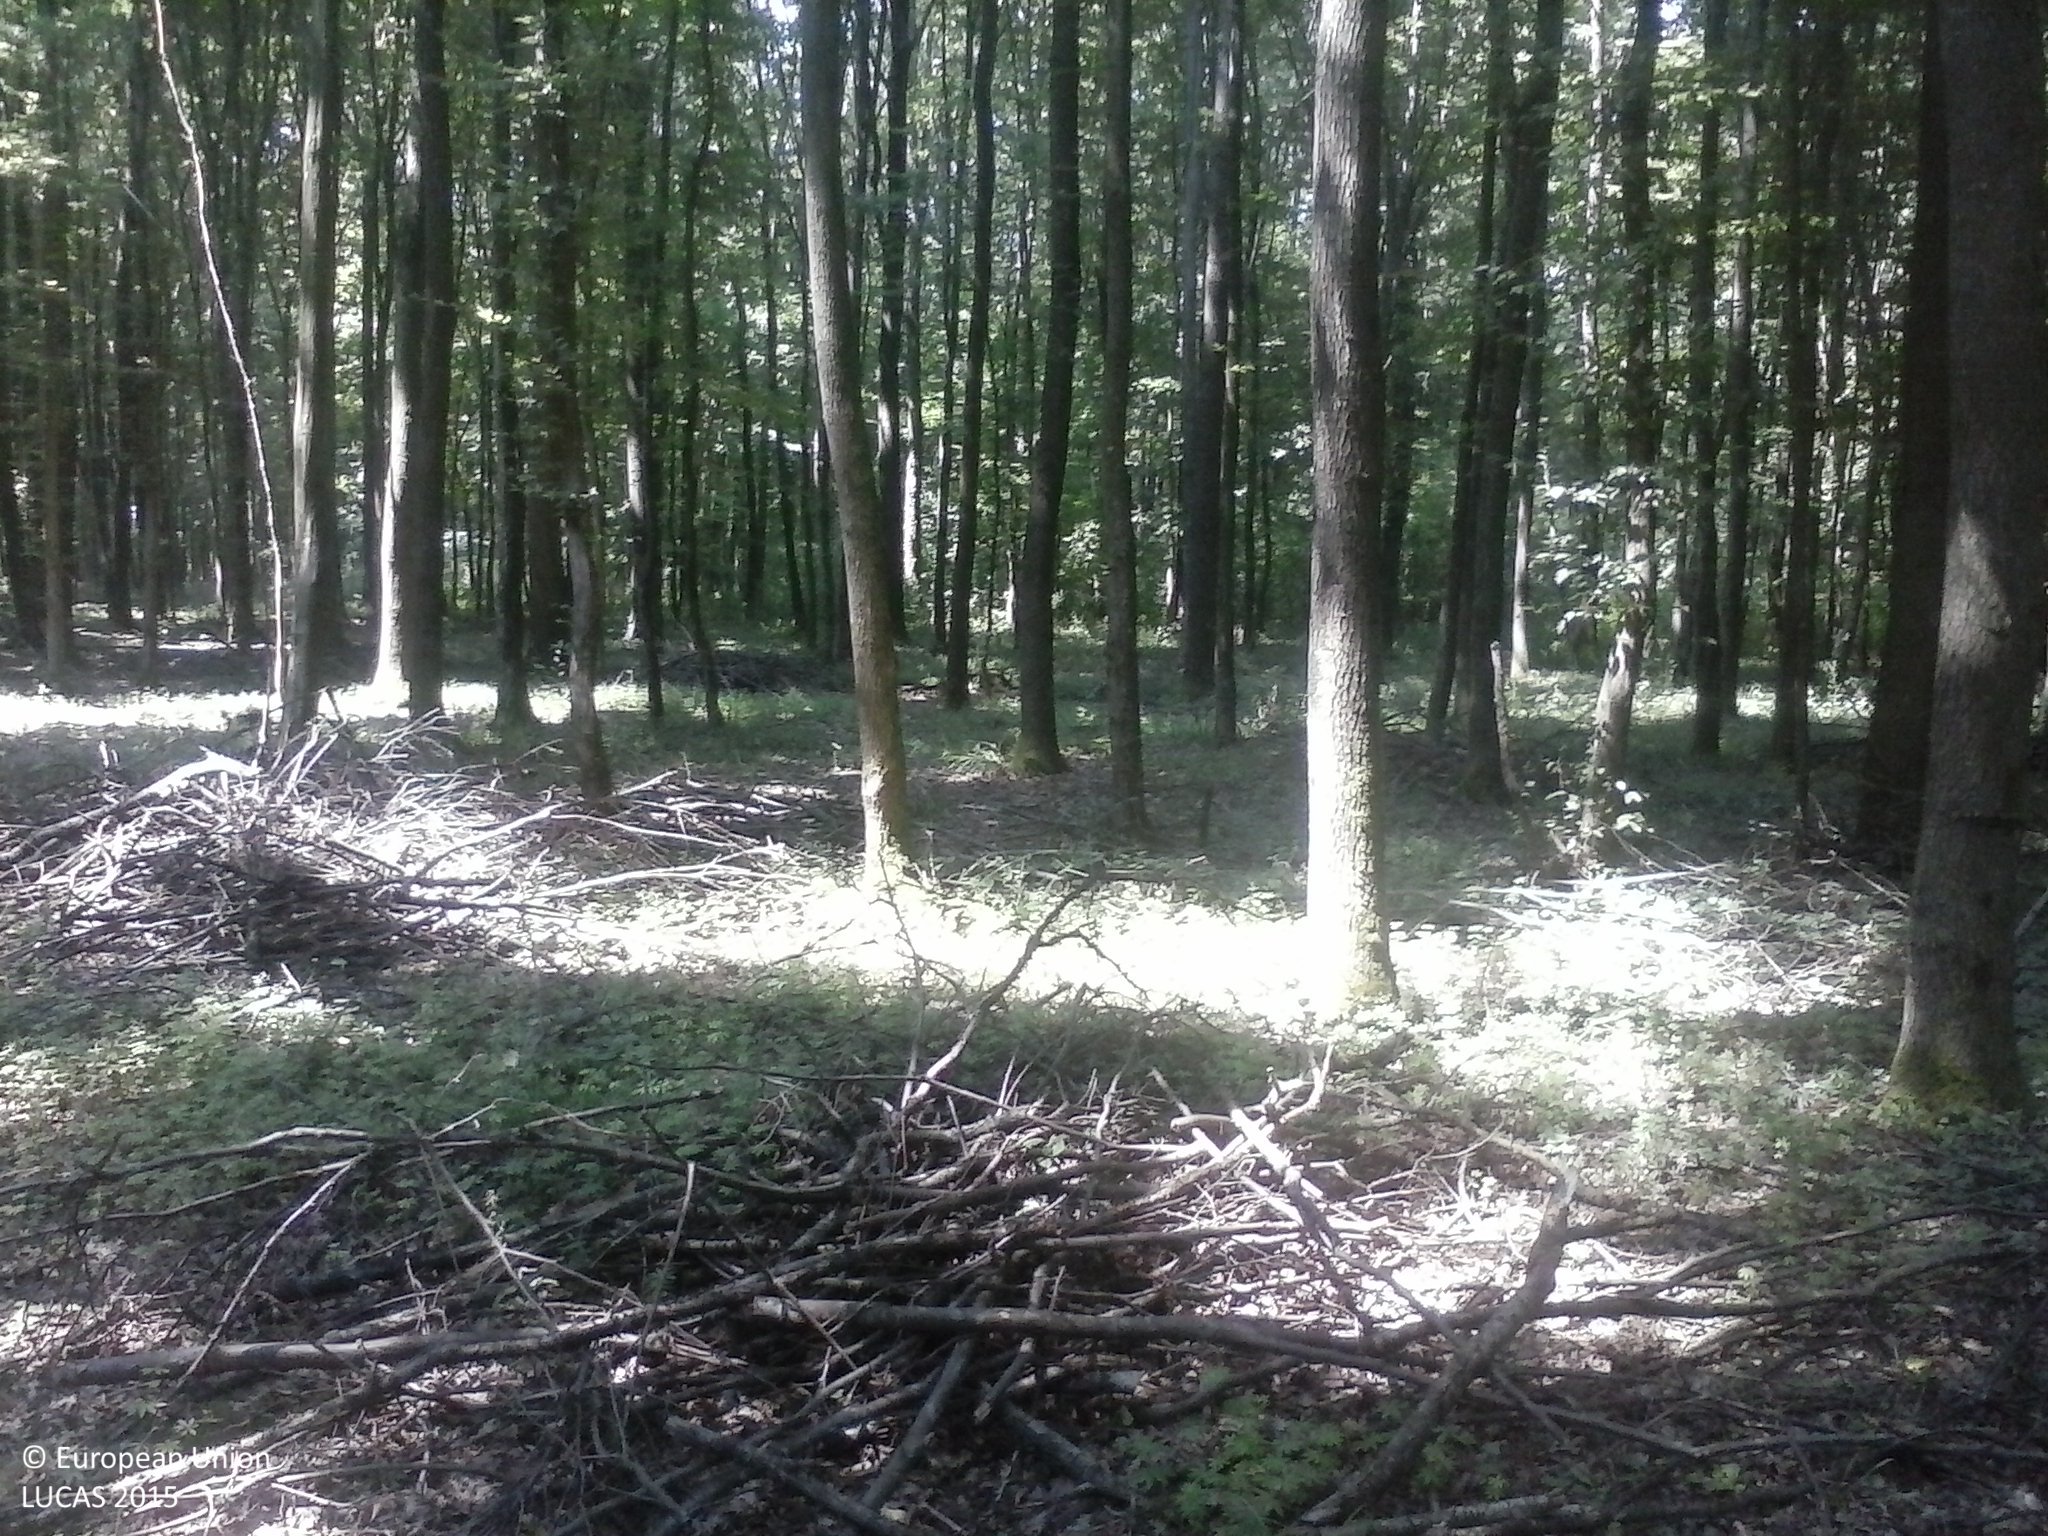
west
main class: Woodland
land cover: Broadleaved woodland
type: mesophytic deciduous forest
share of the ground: > 75 %
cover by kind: broadleaved forest trees 90 %, shrubs 5 %, consolidated bare surface 5 %
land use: Forestry
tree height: > 5 m
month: August
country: HU
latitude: 45.8747
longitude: 17.6951
